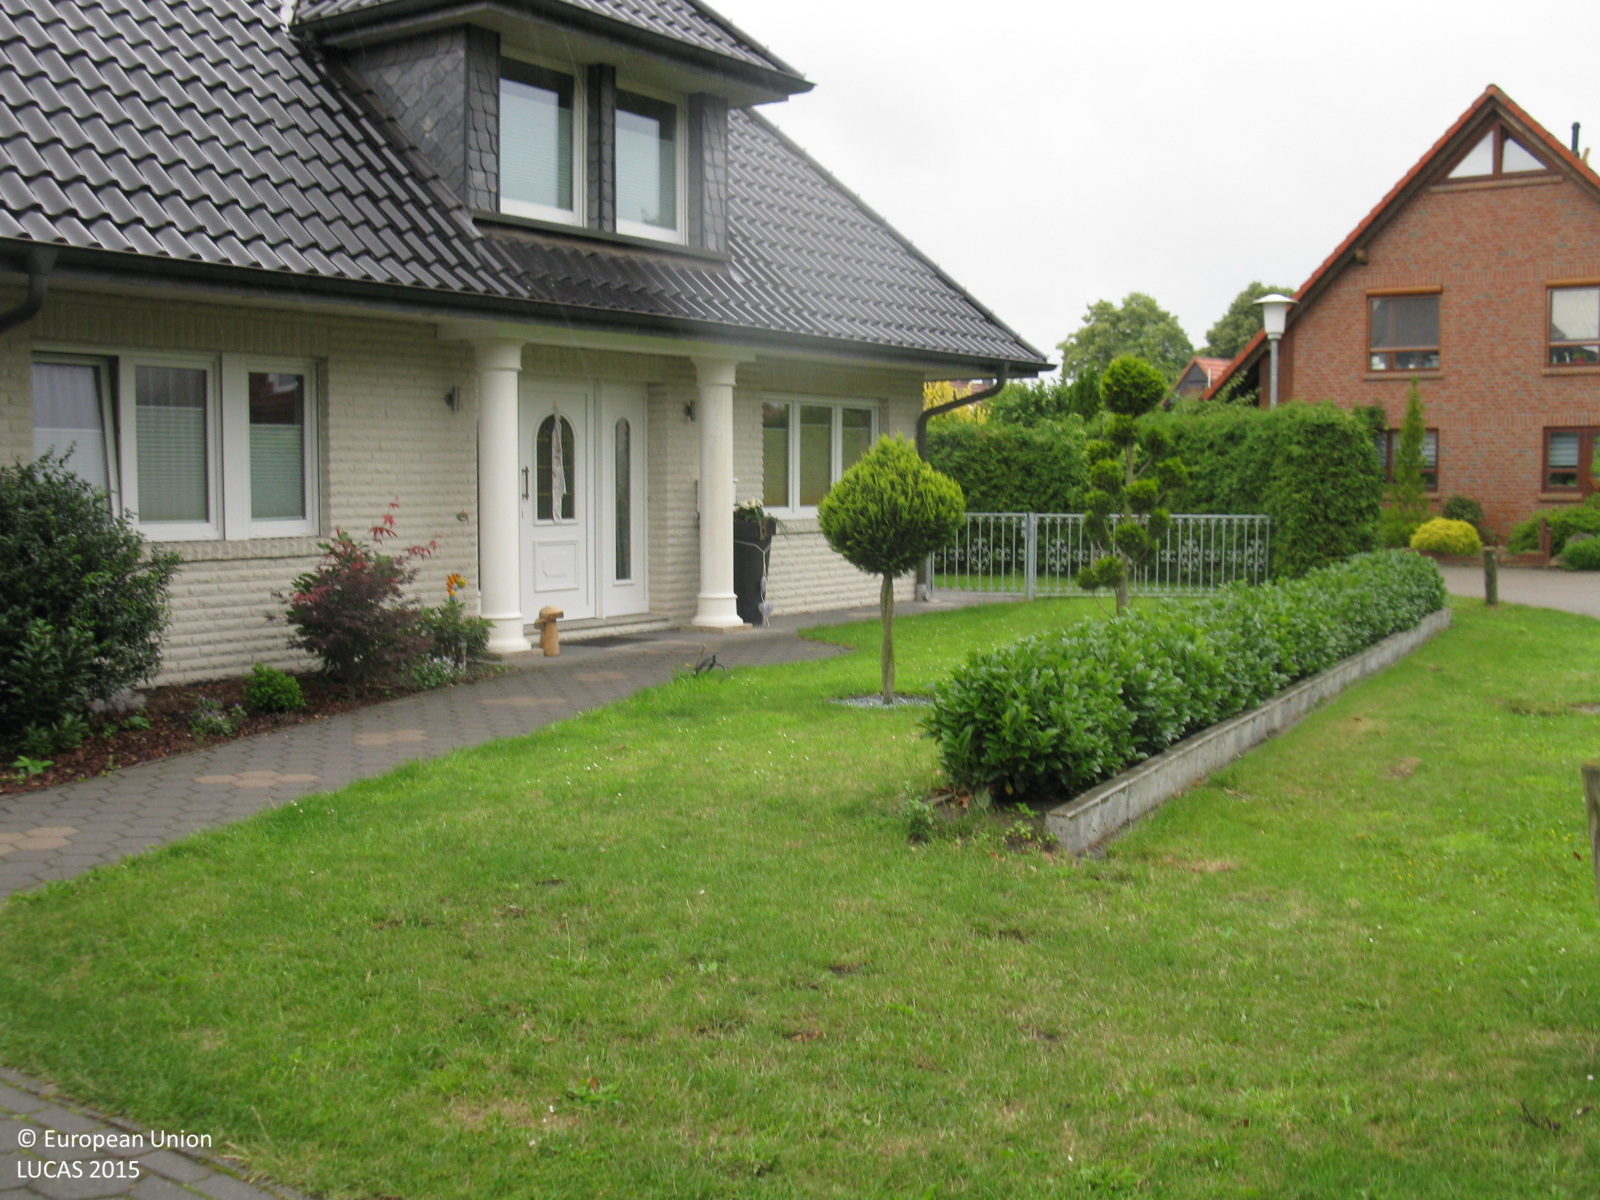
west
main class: Grassland
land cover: Grassland with sparse tree/shrub cover
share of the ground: > 75 %
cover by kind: herbaceous plants 95 %, broadleaved forest trees 5 %
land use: Residential
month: July
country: DE
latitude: 53.0881
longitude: 8.5821
